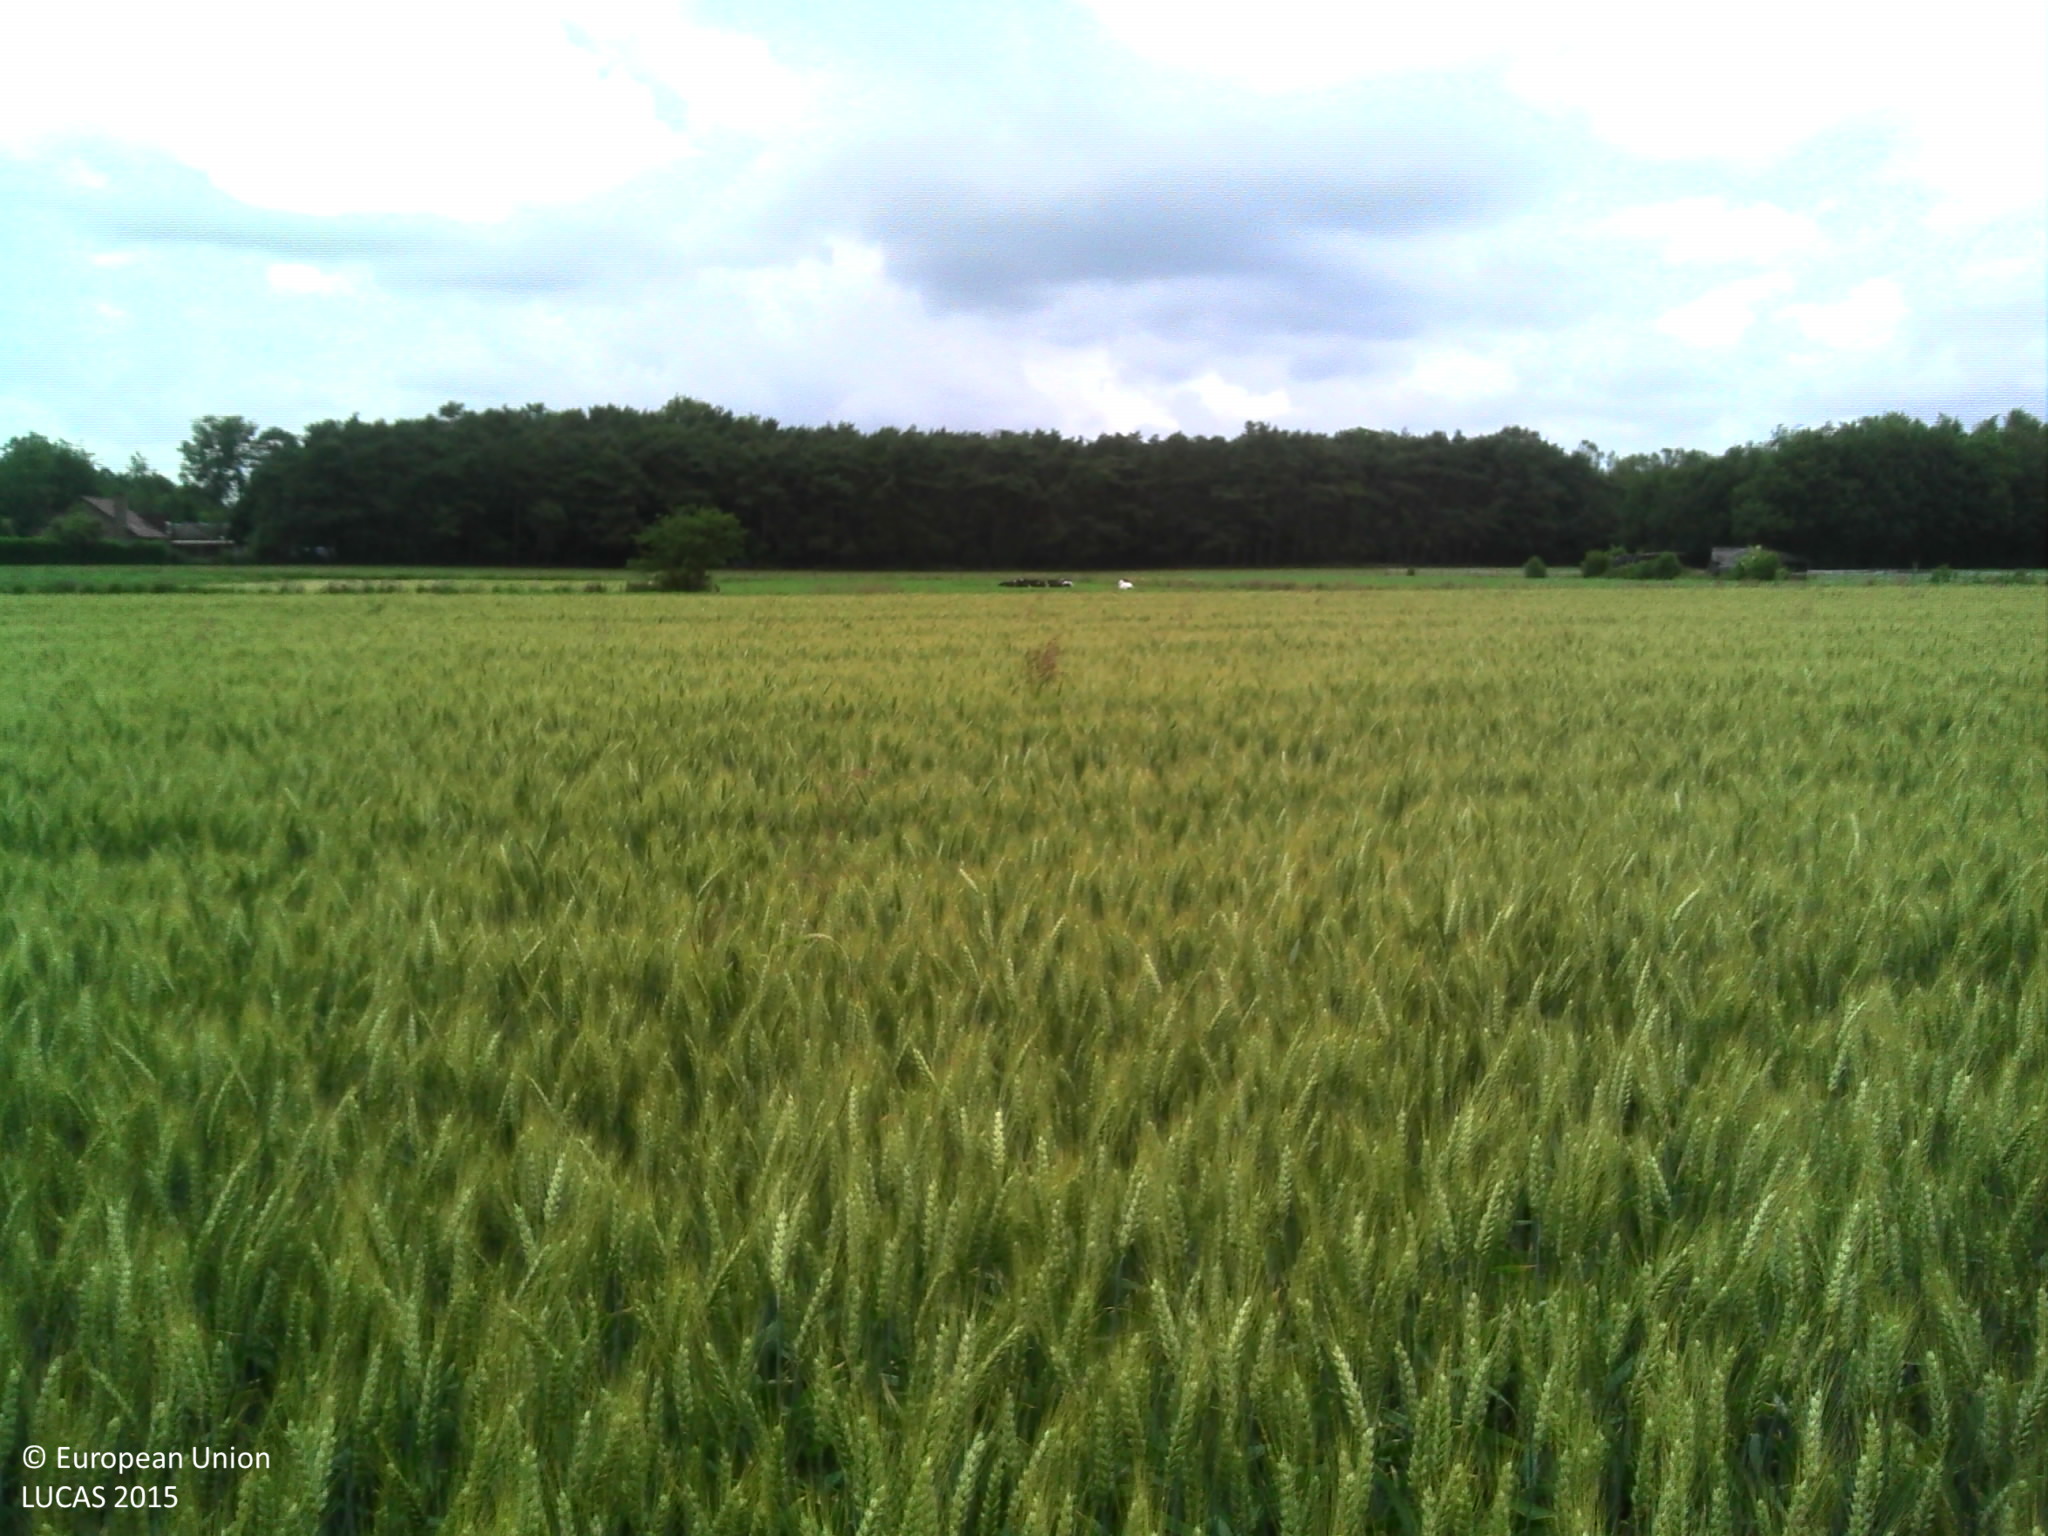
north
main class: Cropland
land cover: Common wheat
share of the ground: > 75 %
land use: Agriculture (excluding fallow land and kitchen gardens)
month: June
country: BE
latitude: 51.1981
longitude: 3.9979
